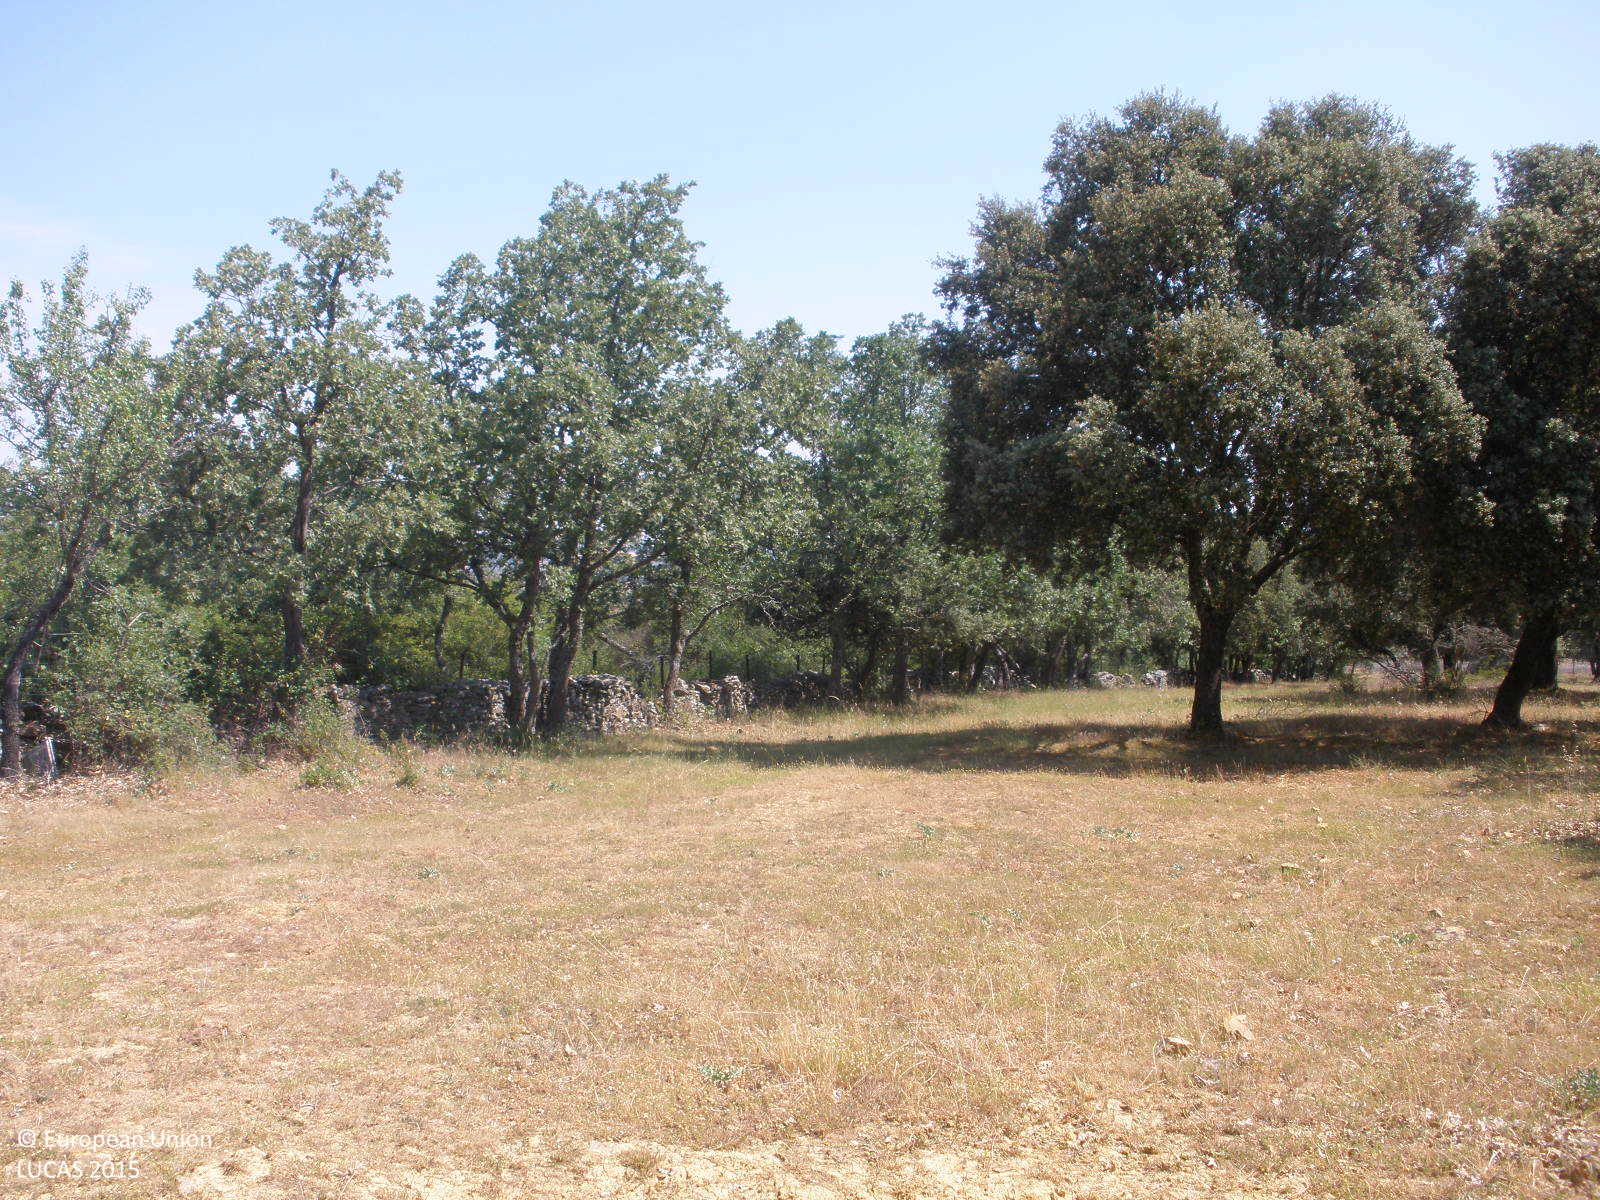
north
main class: Woodland
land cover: Broadleaved woodland
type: broadleaved evergreen forest
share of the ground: 25 - 50 %
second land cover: Grassland without tree/shrub cover
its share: > 75 %
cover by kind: herbaceous plants 80 %, broadleaved forest trees 20 %
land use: Forestry
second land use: Agriculture (excluding fallow land and kitchen gardens)
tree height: > 5 m
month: June
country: ES
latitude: 40.6424
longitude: -6.0798
